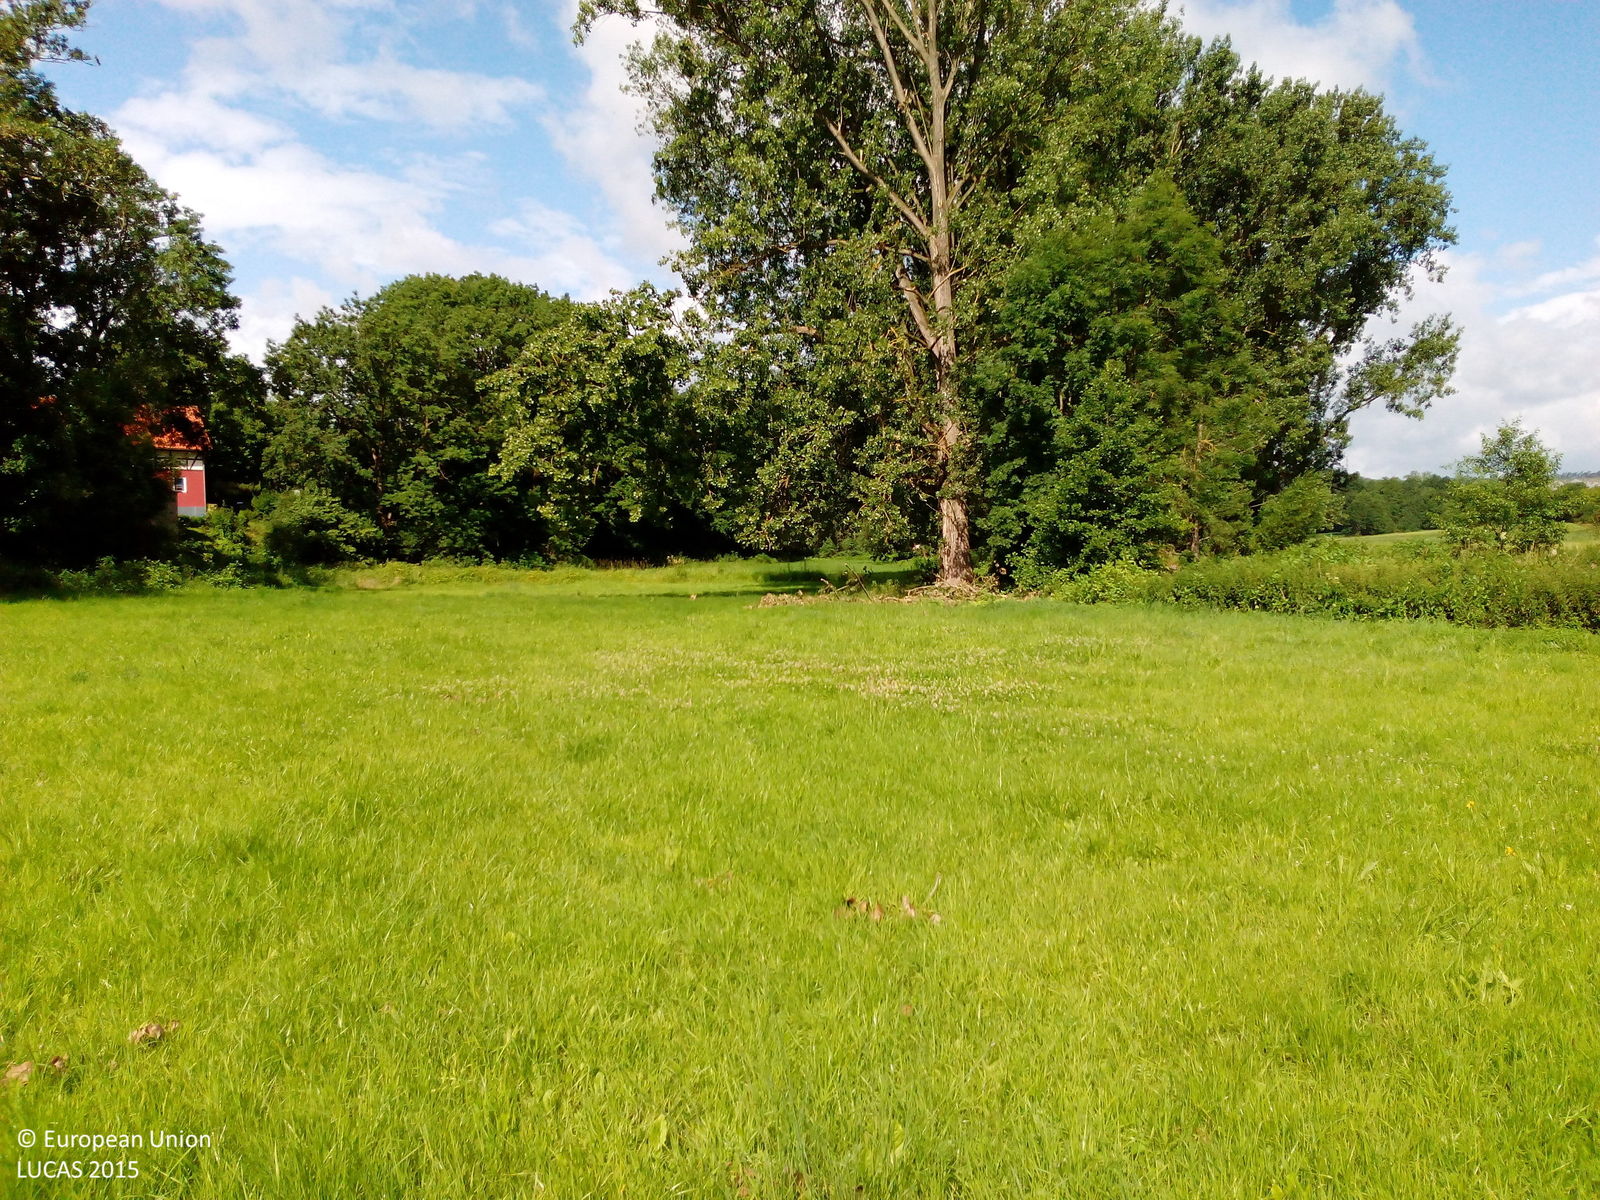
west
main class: Grassland
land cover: Grassland without tree/shrub cover
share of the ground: > 75 %
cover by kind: herbaceous plants 100 %
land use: Agriculture (excluding fallow land and kitchen gardens)
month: July
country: DE
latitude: 51.6404
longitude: 9.8700
